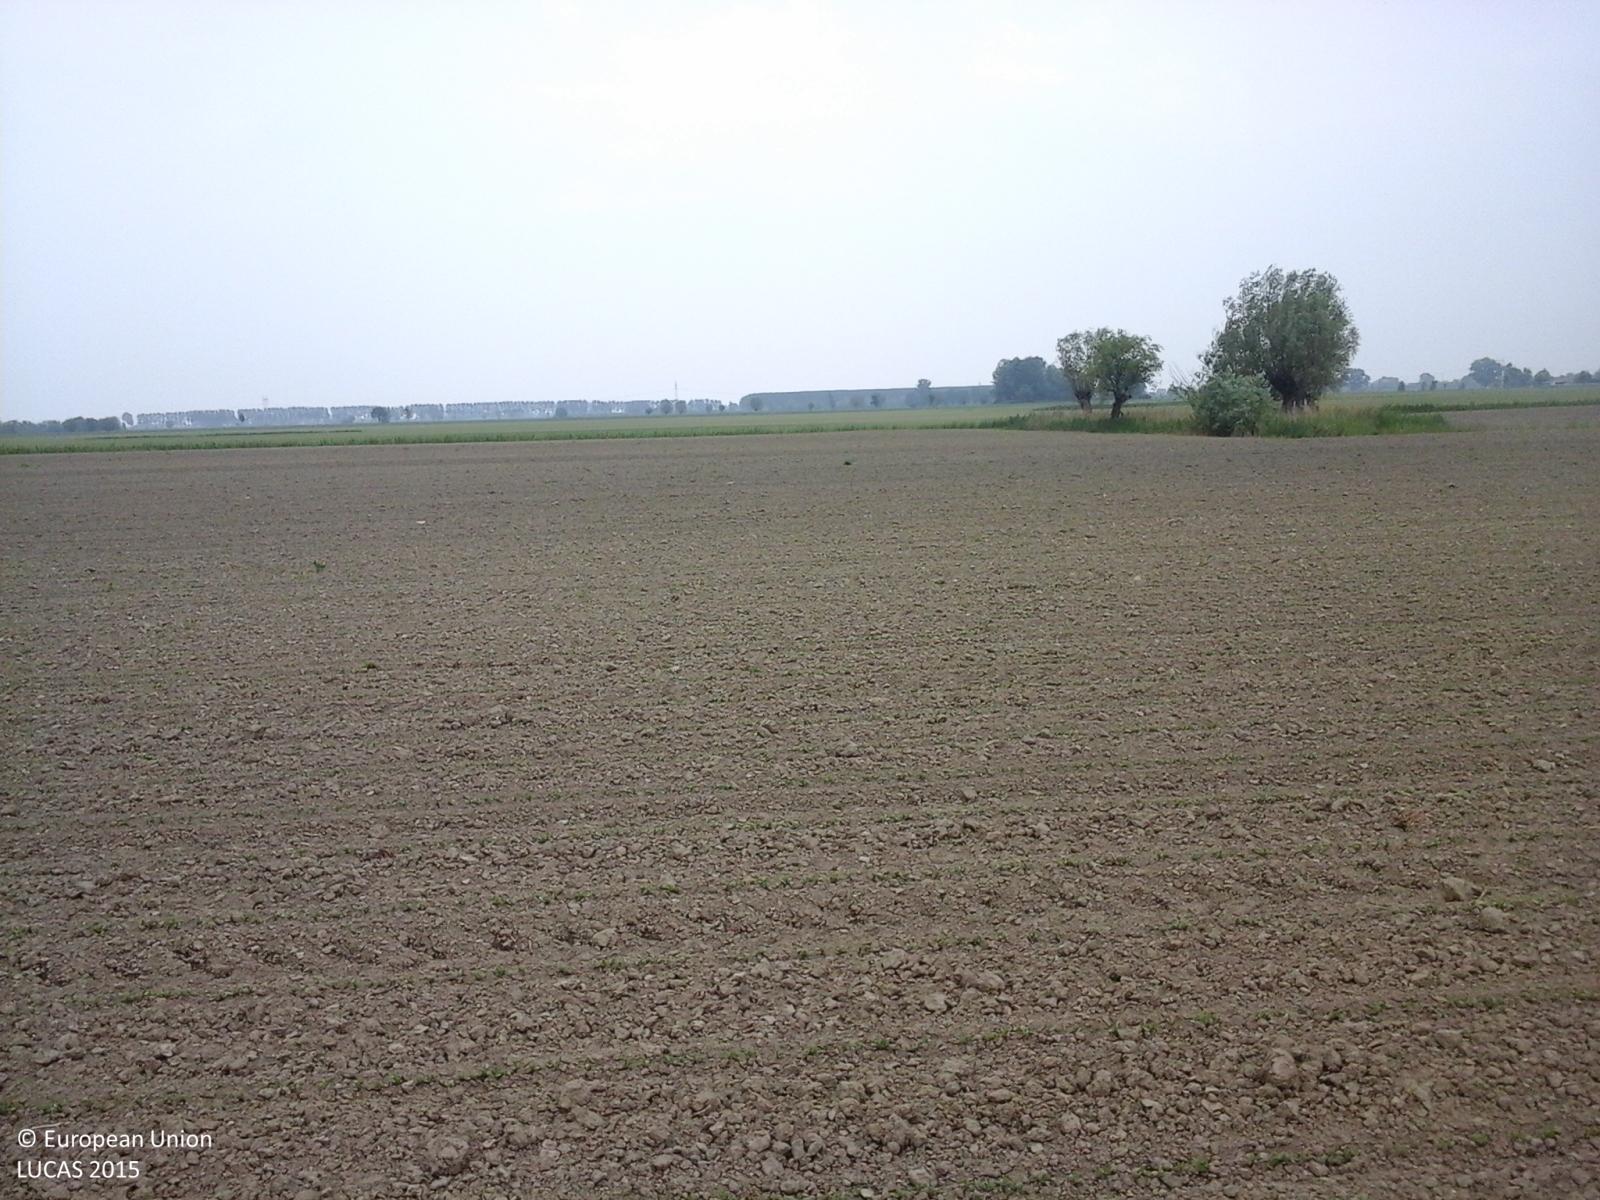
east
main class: Cropland
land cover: Soya
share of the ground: > 75 %
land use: Agriculture (excluding fallow land and kitchen gardens)
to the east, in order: Soya; Ditches and canals; Soya; Ditches and canals; Grass margins; Maize; Ditches and canals; Maize; Ditches and canals; Maize
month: May
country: IT
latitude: 44.9701
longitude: 11.5566
